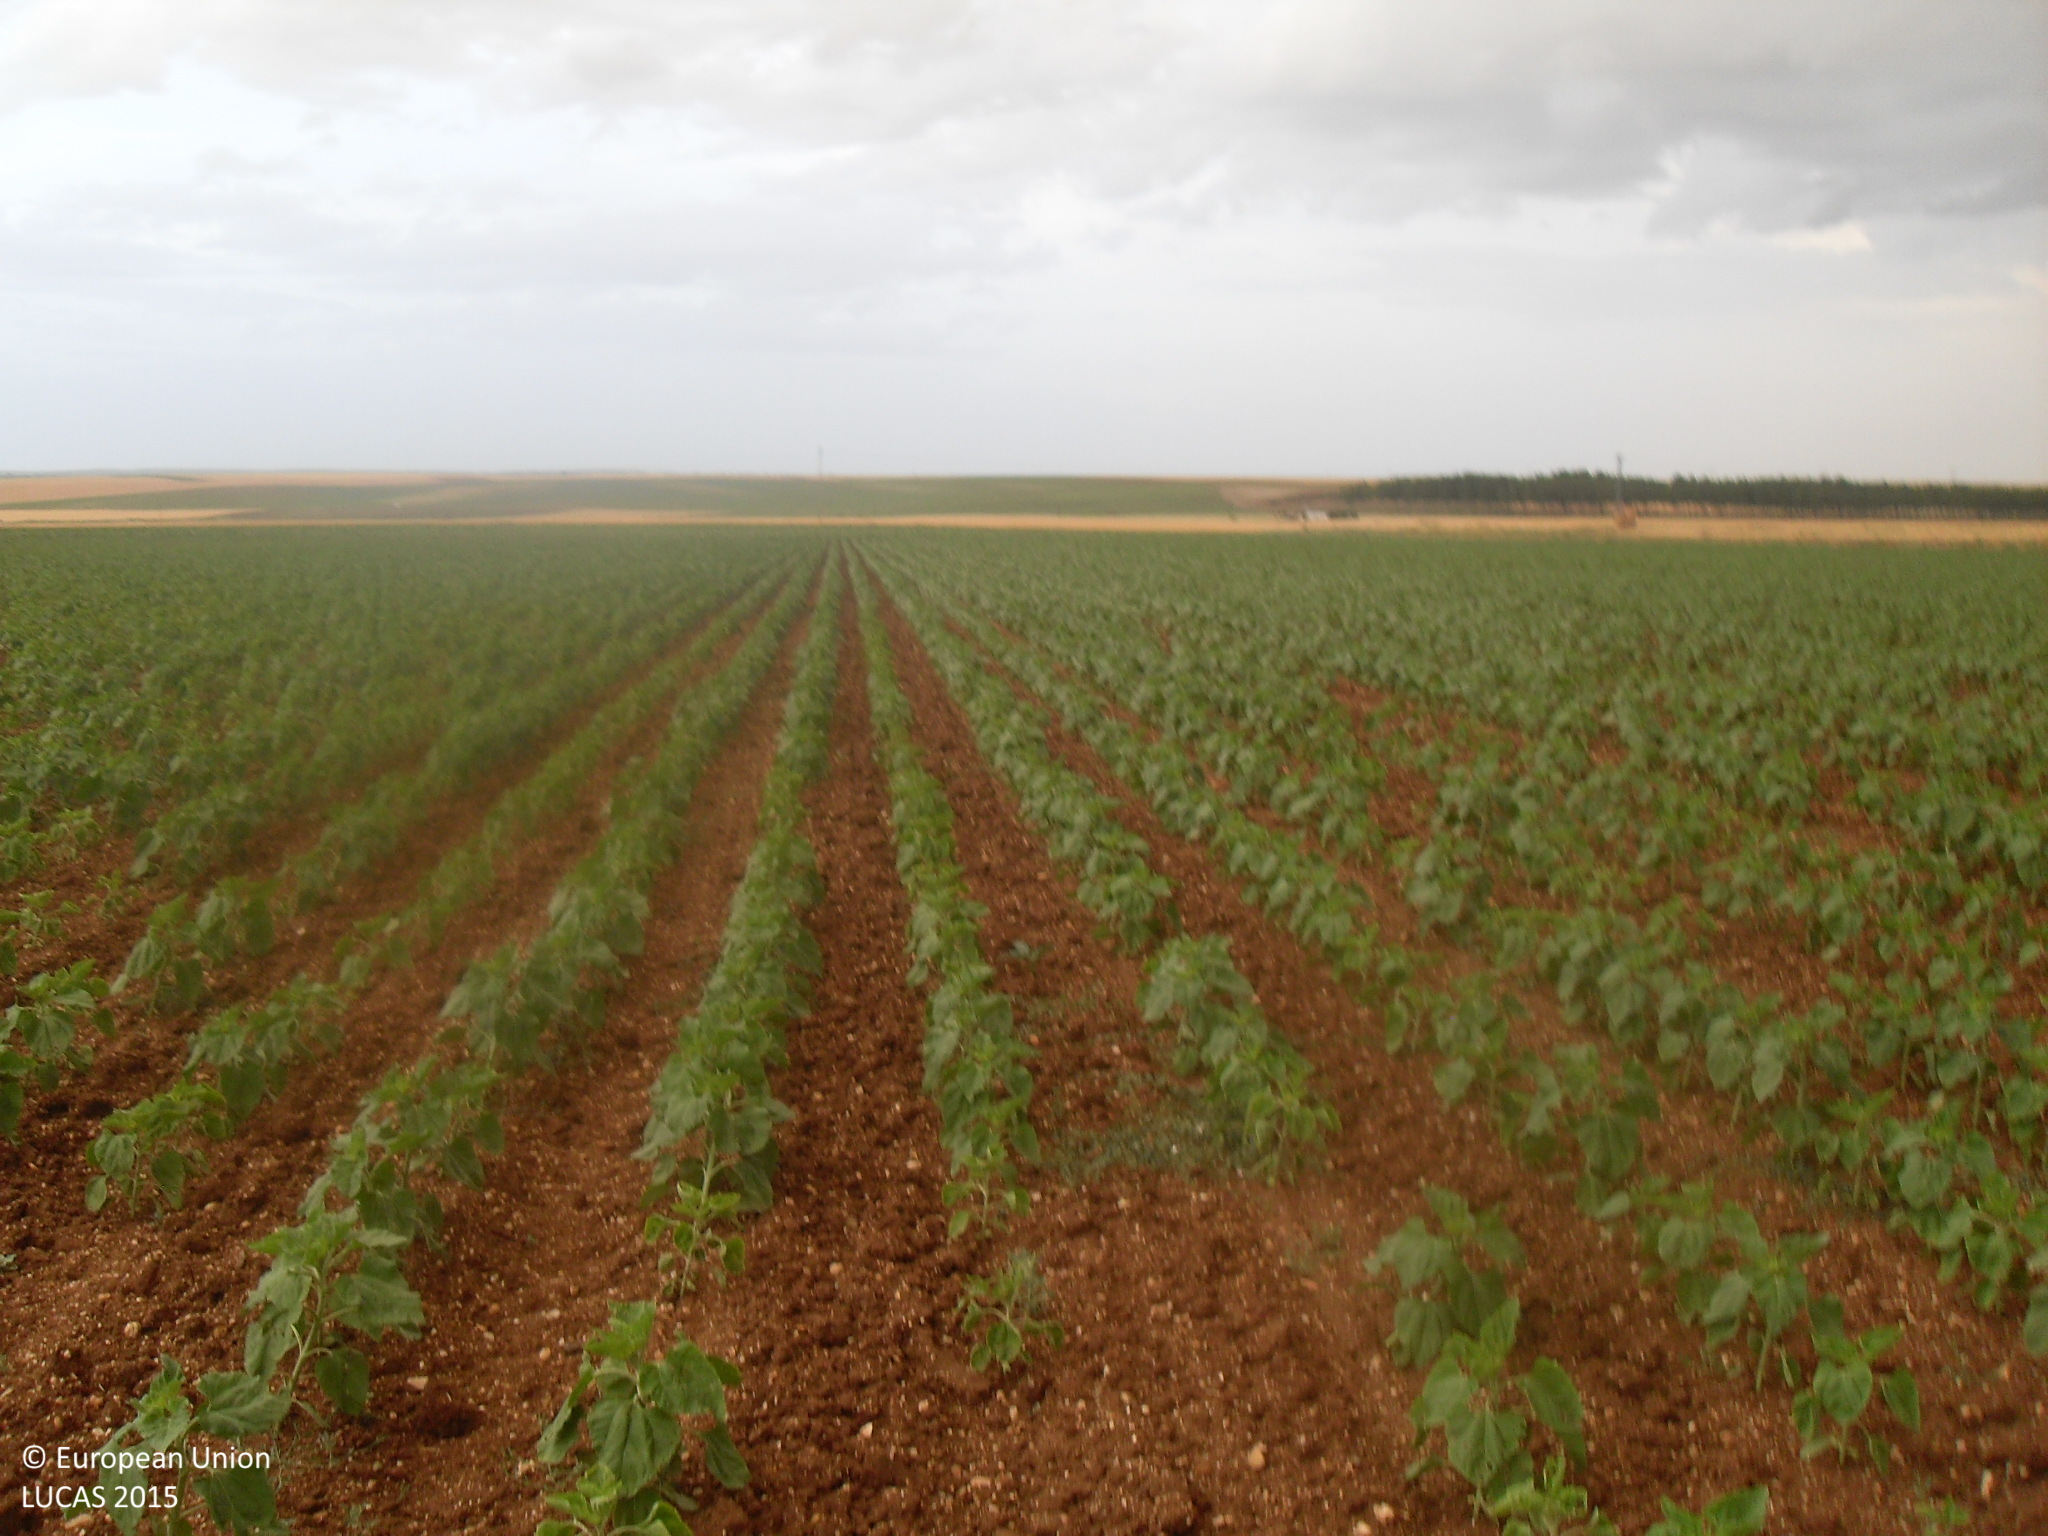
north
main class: Cropland
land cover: Sunflower
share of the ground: 25 - 50 %
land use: Agriculture (excluding fallow land and kitchen gardens)
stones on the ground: < 10 %
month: June
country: ES
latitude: 41.0847
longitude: -5.7338
